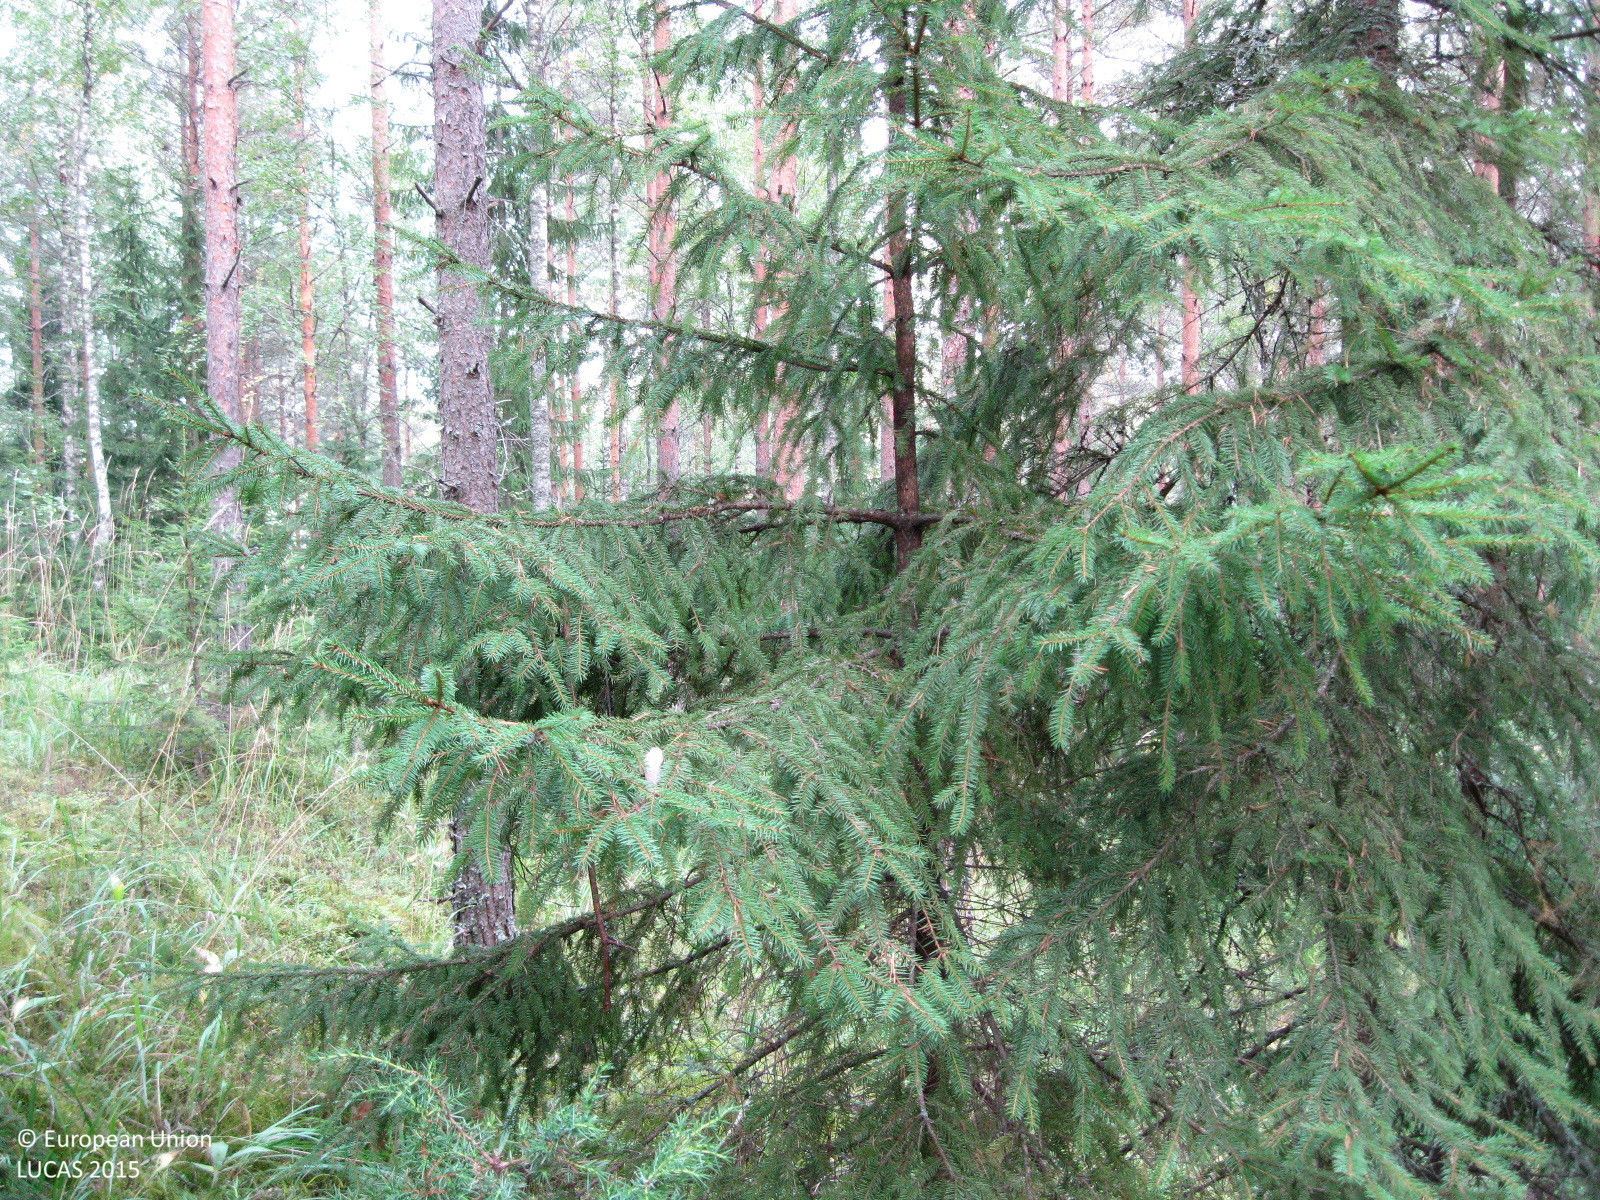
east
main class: Woodland
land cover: Other coniferous woodland
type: boreal forest
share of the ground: 50 - 75 %
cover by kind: coniferous forest trees 60 %, shrubs 15 %, broadleaved forest trees 10 %, lichens and mosses 10 %, herbaceous plants 5 %
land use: Forestry
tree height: > 5 m
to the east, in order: Other coniferous woodland; Other mixed woodland; Broadleaved woodland; Tracks; Broadleaved woodland
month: September
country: FI
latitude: 60.5454
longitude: 24.6764
